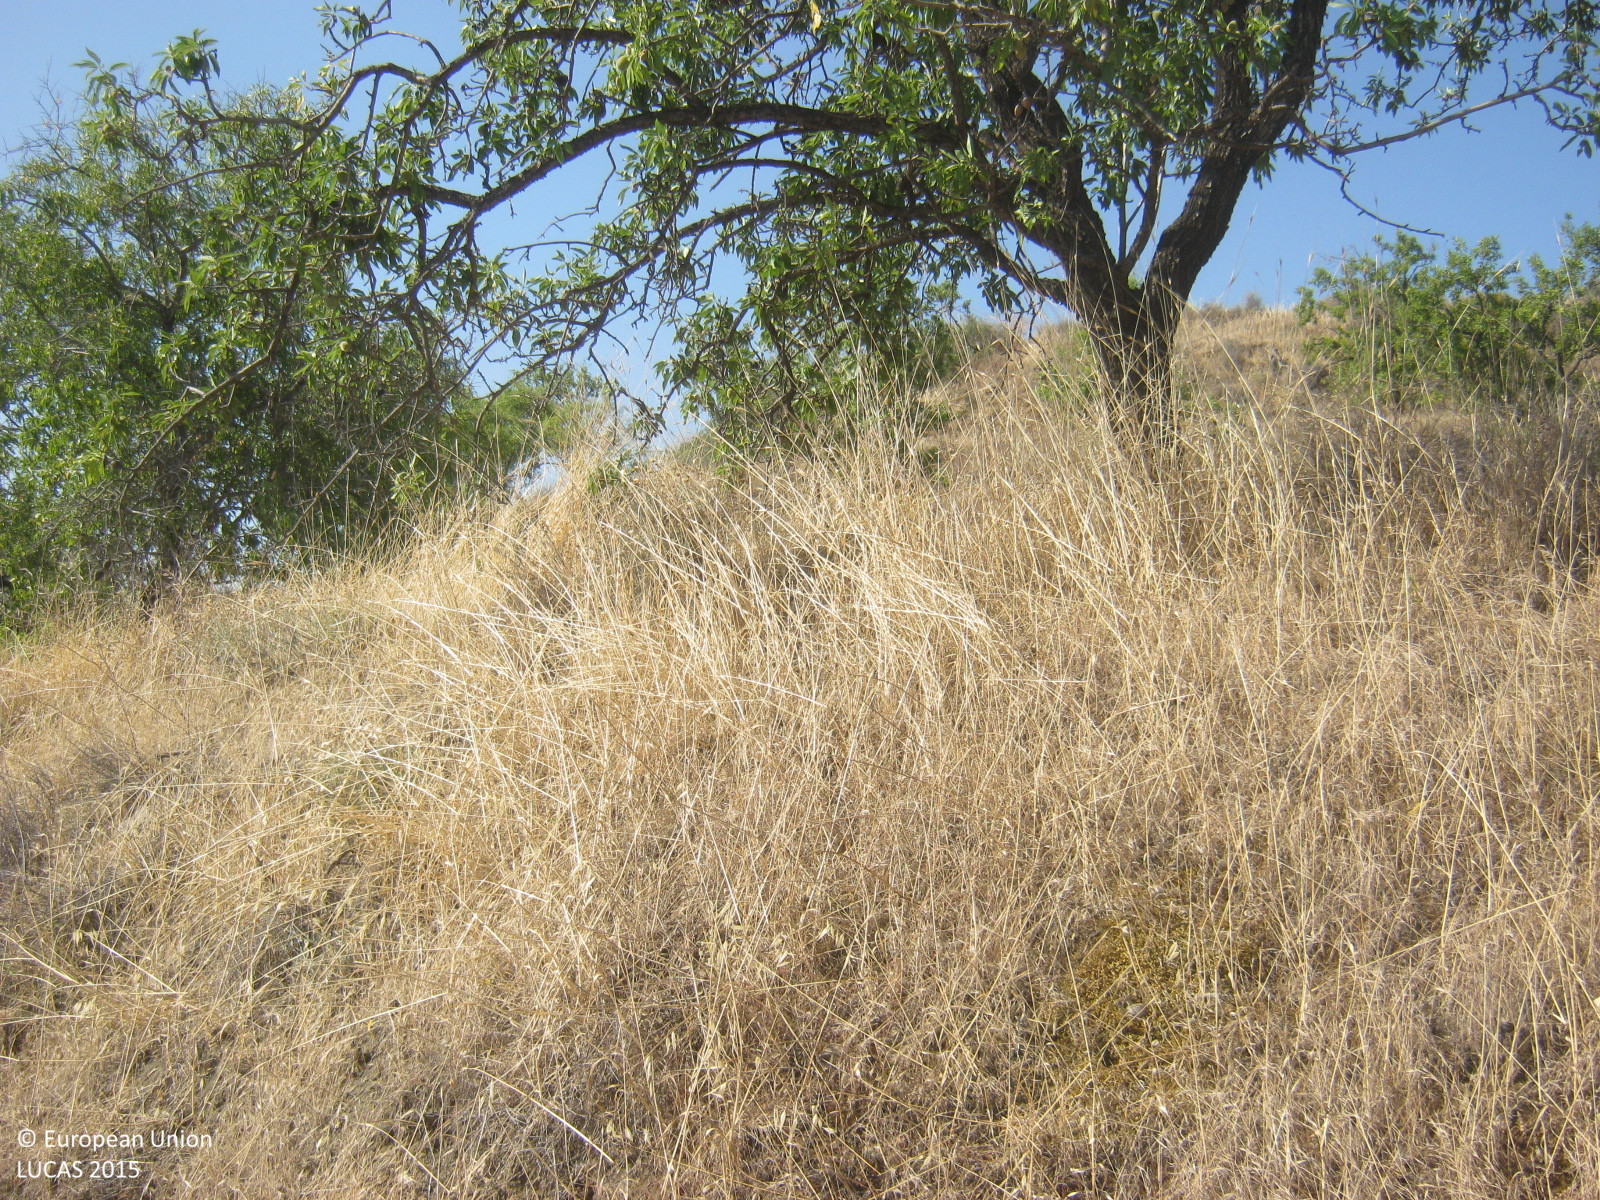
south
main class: Cropland
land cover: Nuts trees
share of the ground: 10 - 25 %
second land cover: Spontaneously vegetated surfaces
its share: > 75 %
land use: Agriculture (excluding fallow land and kitchen gardens)
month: May
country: CY
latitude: 35.0757
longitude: 32.9984
